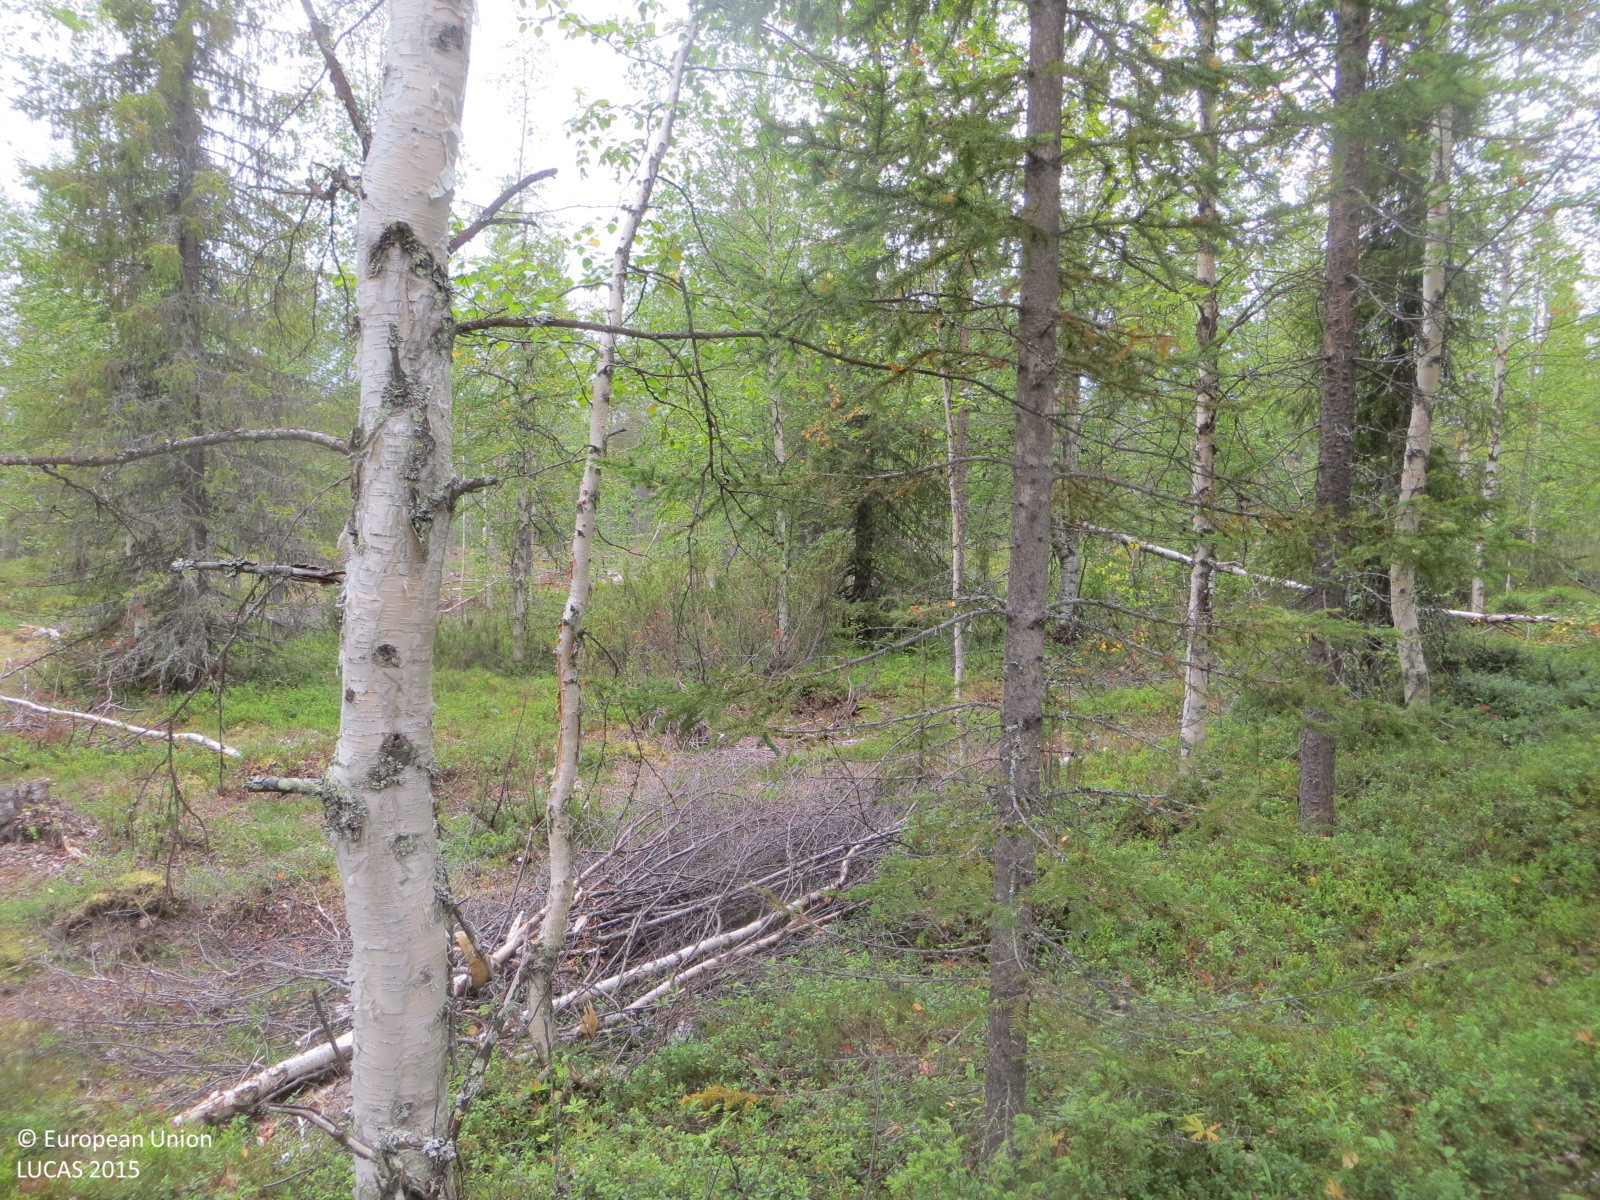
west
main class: Woodland
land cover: Pine dominated mixed woodland
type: boreal forest
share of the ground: 50 - 75 %
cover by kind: broadleaved forest trees 40 %, shrubs 40 %, coniferous forest trees 20 %
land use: Forestry
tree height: > 5 m
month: August
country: FI
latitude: 67.9943
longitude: 25.1732
